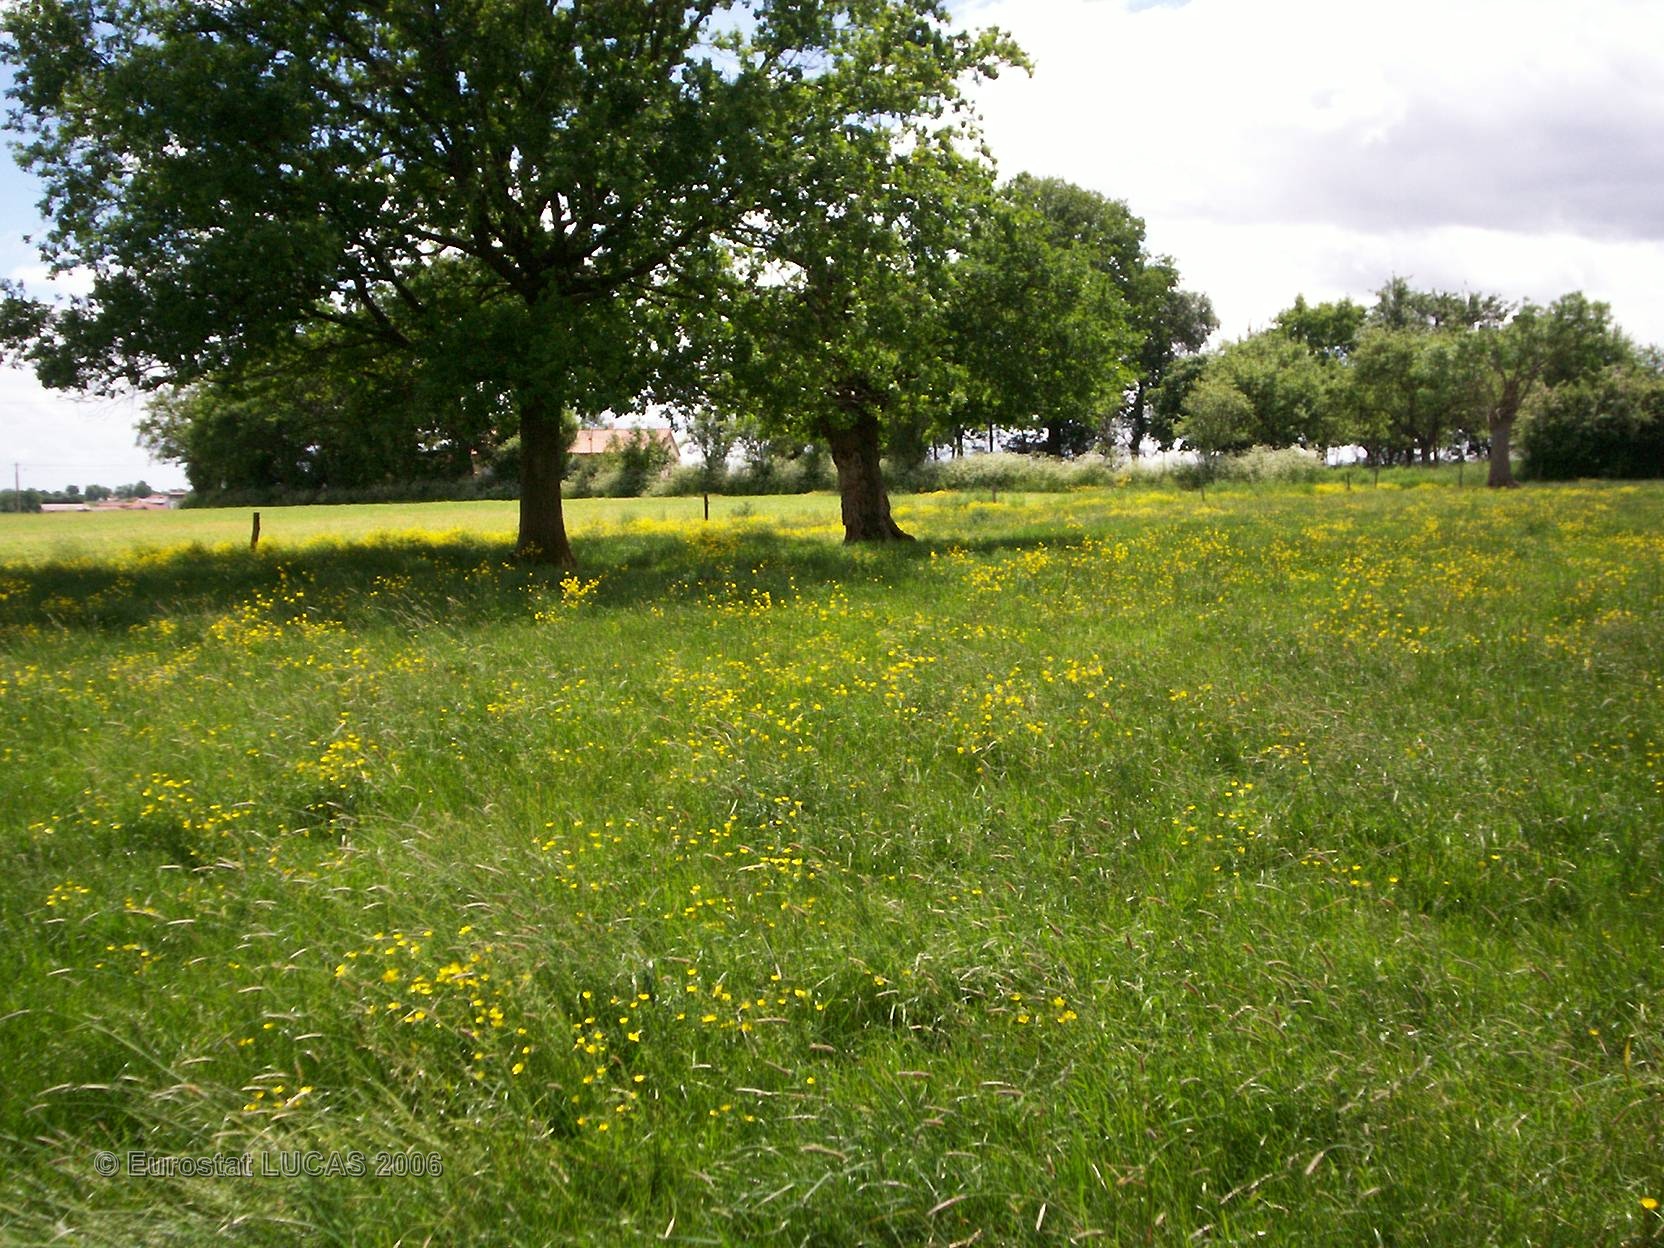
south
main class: Grassland
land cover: Grassland with sparse tree/shrub cover
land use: Agriculture (excluding fallow land and kitchen gardens)
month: May
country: FR
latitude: 47.2644
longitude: -1.0720
